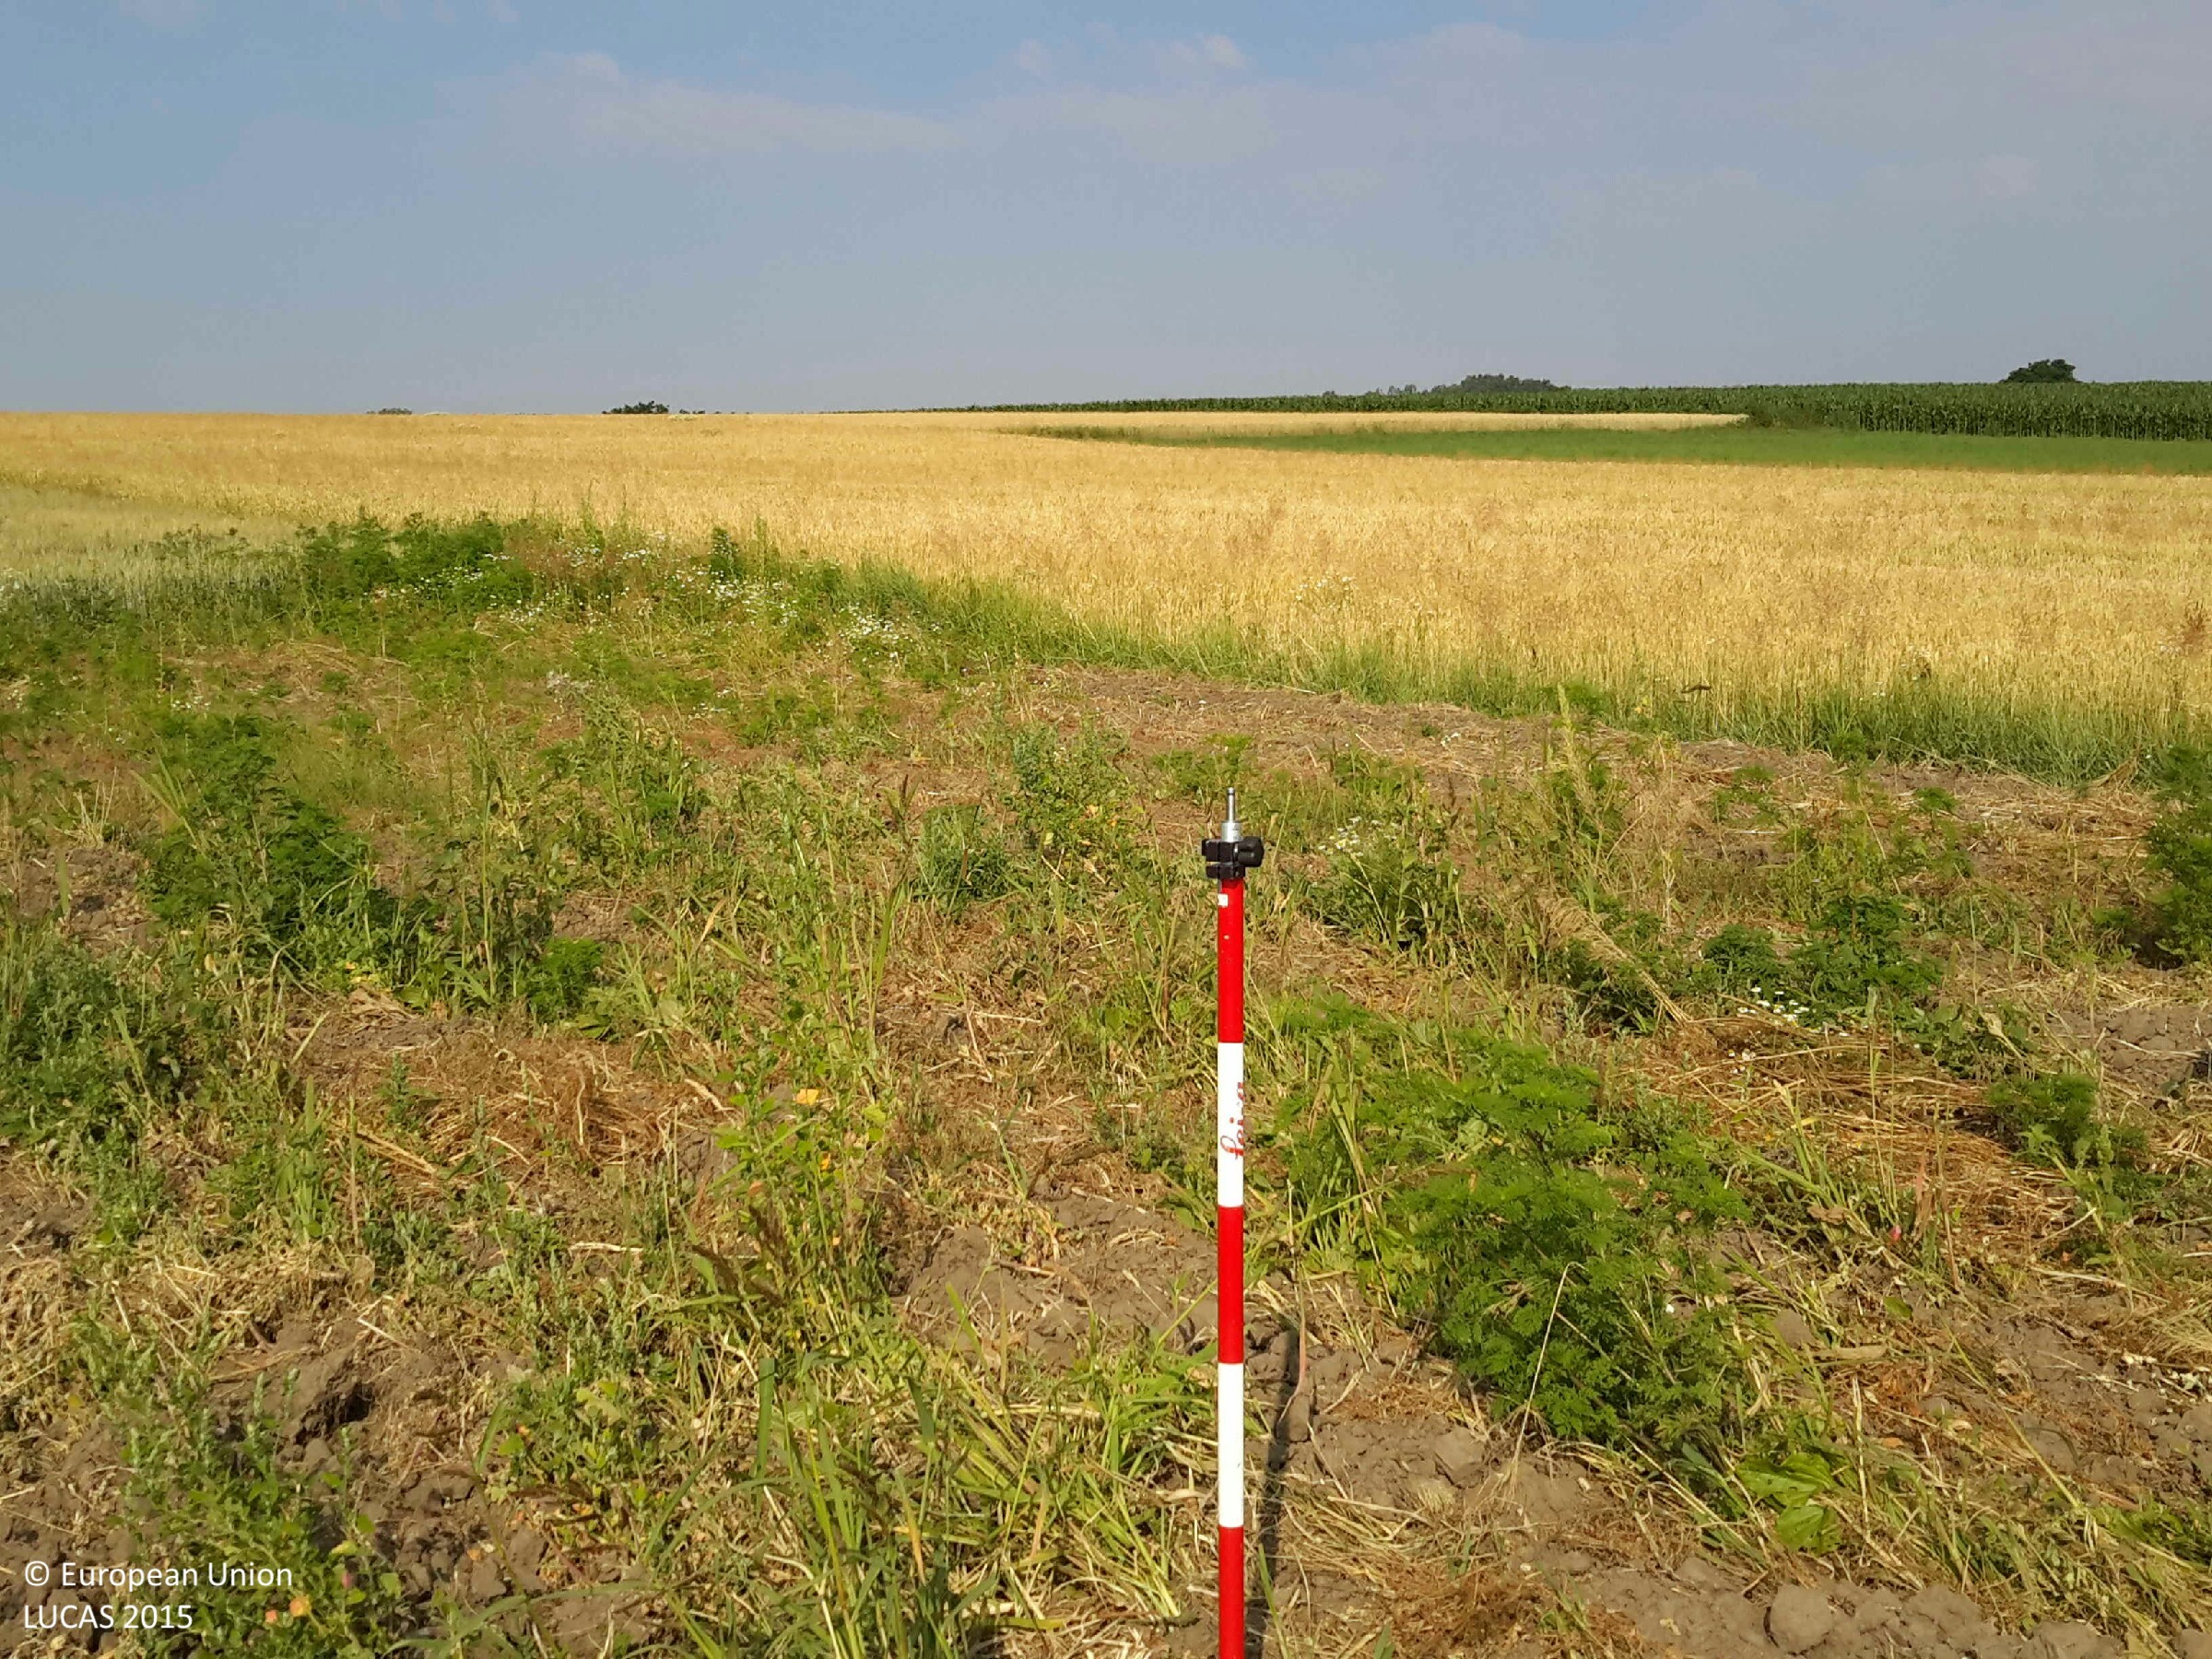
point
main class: Grassland
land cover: Spontaneously vegetated surfaces
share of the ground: 50 - 75 %
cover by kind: herbaceous plants 60 %, unconsolidated bare surface 40 %
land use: Fallow land
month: July
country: HU
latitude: 47.3918
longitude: 17.4662
